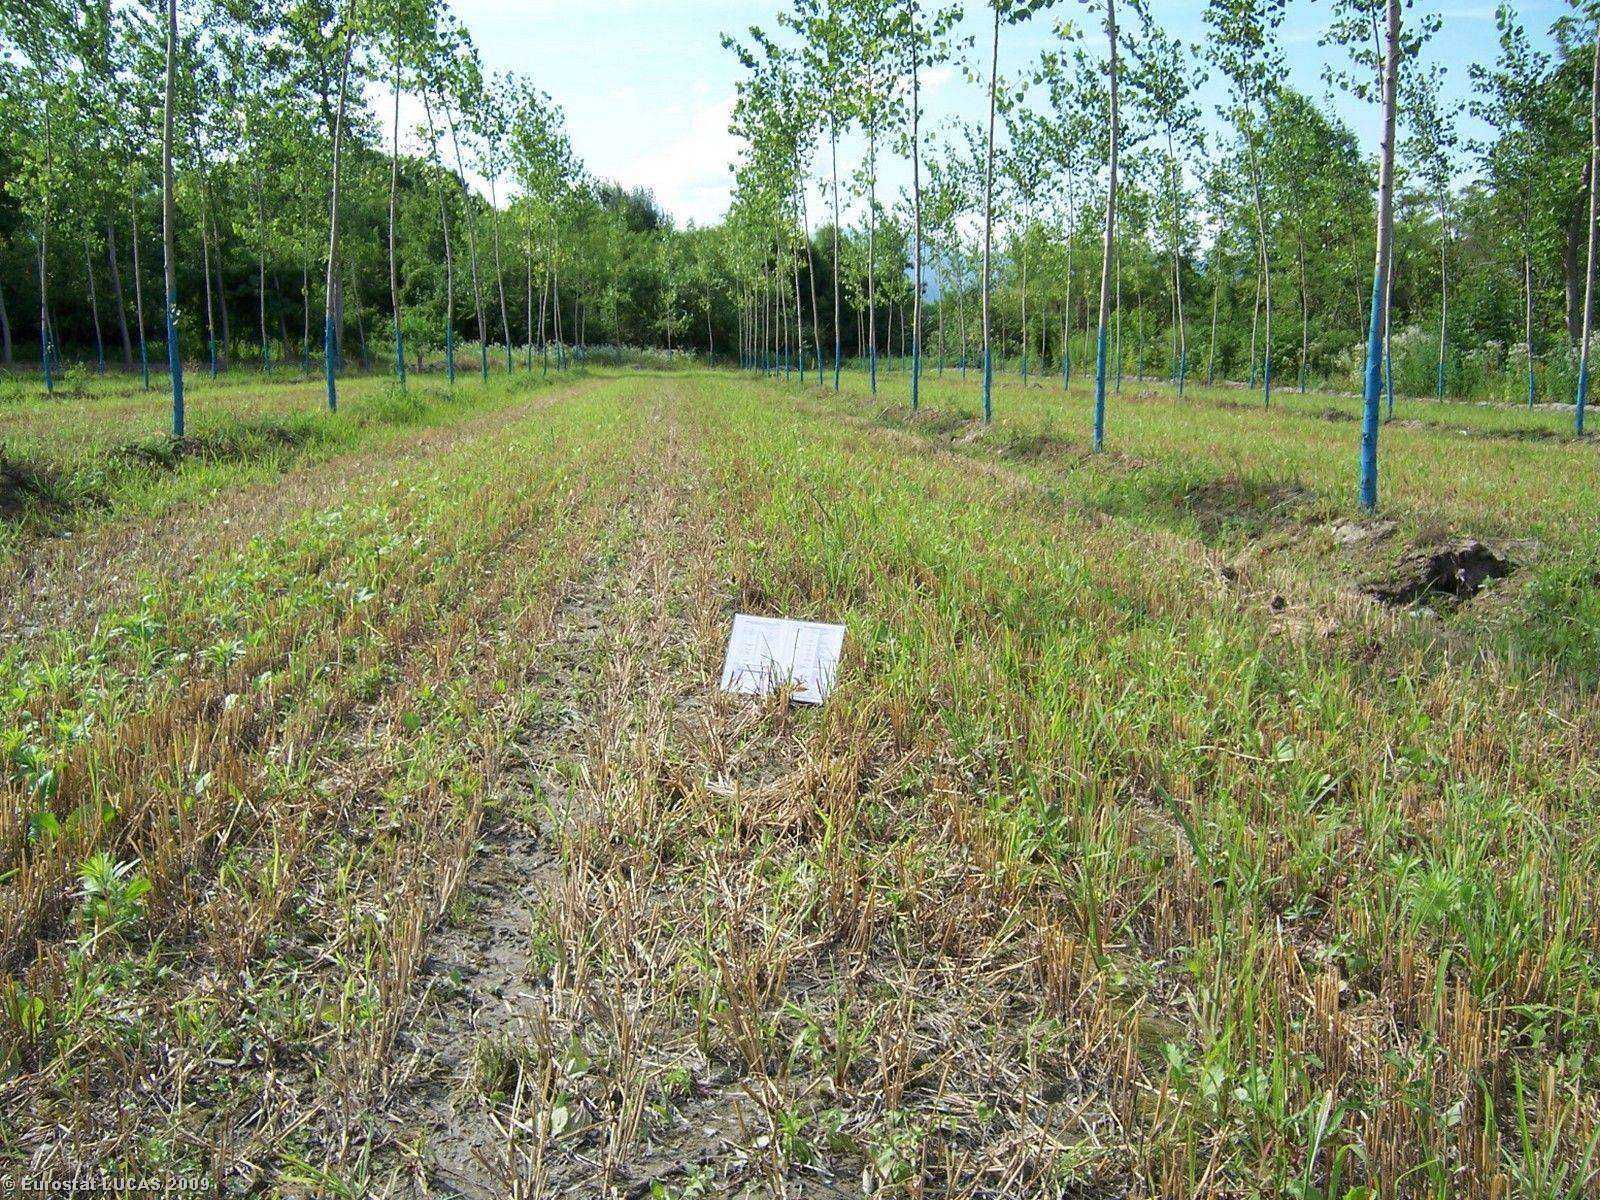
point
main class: Woodland
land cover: Broadleaved woodland
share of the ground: 25 - 50 %
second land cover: Barley
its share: > 75 %
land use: Forestry
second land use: Agriculture (excluding fallow land and kitchen gardens)
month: July
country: IT
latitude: 44.8409
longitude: 7.3860
